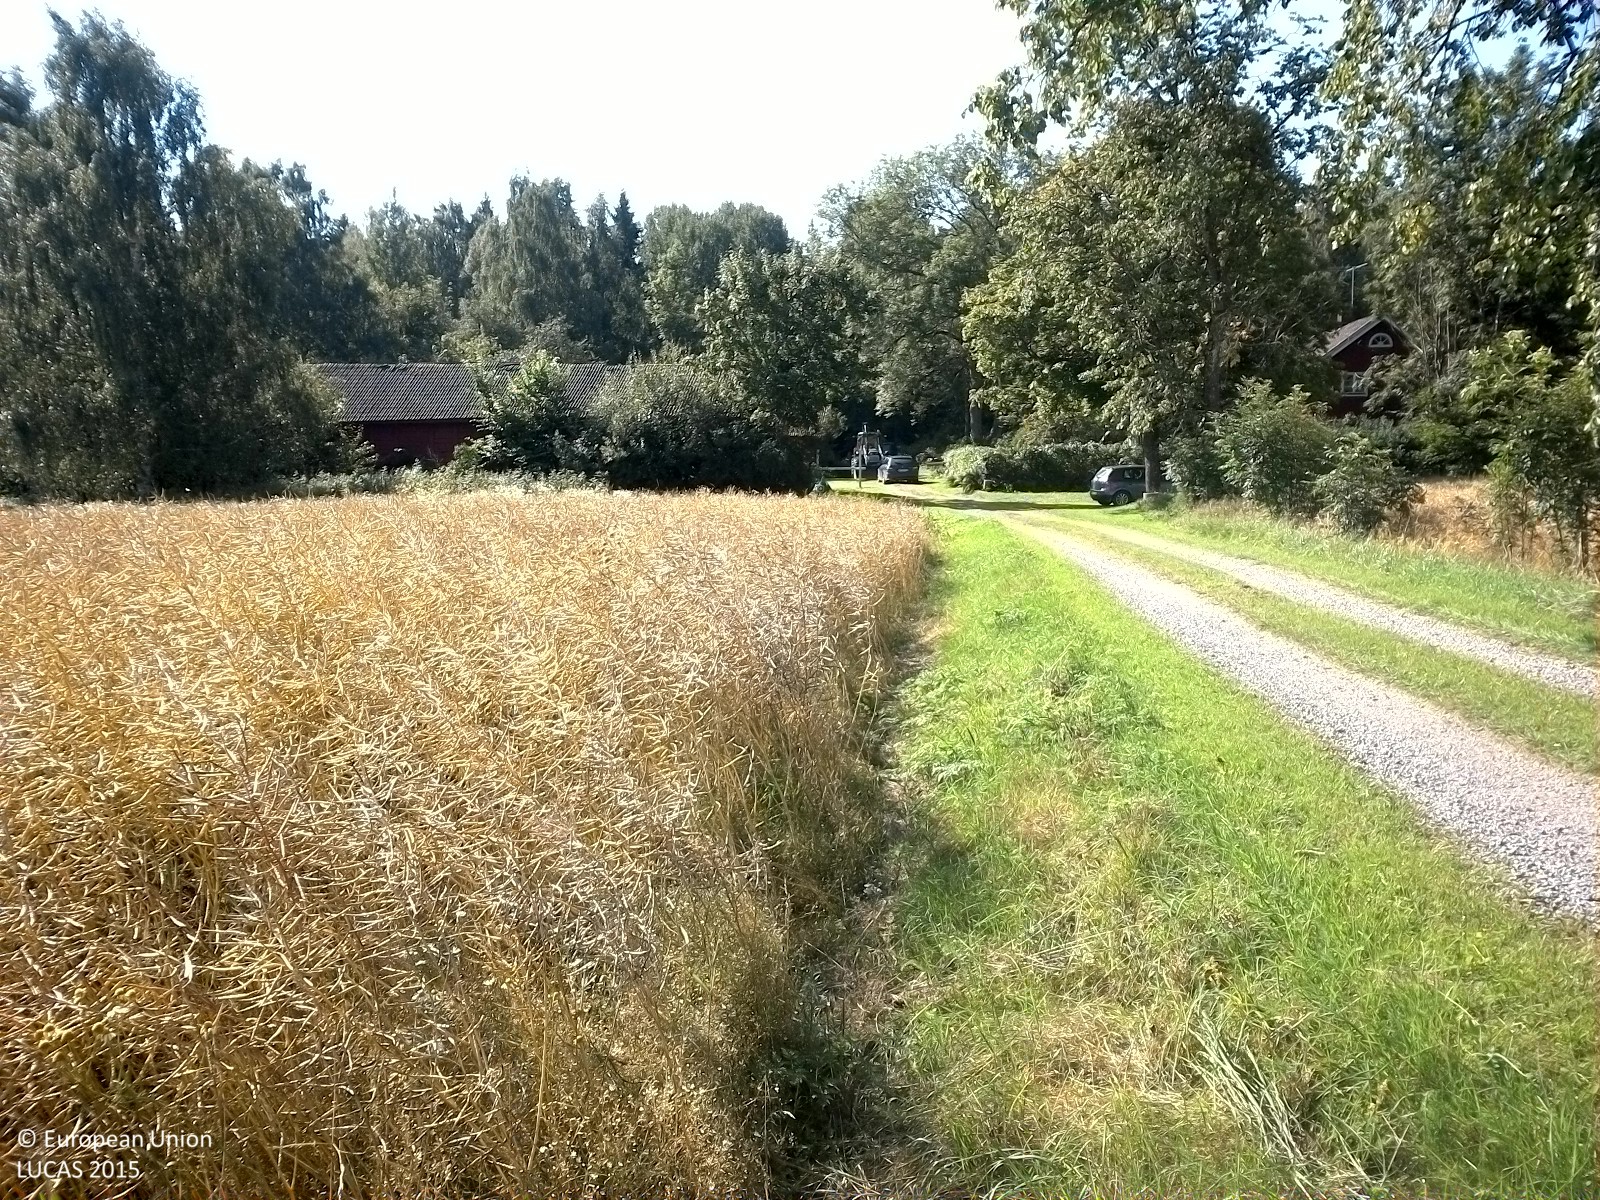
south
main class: Cropland
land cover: Rape and turnip rape
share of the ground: > 75 %
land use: Agriculture (excluding fallow land and kitchen gardens)
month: August
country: SE
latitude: 59.0497
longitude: 15.3791
